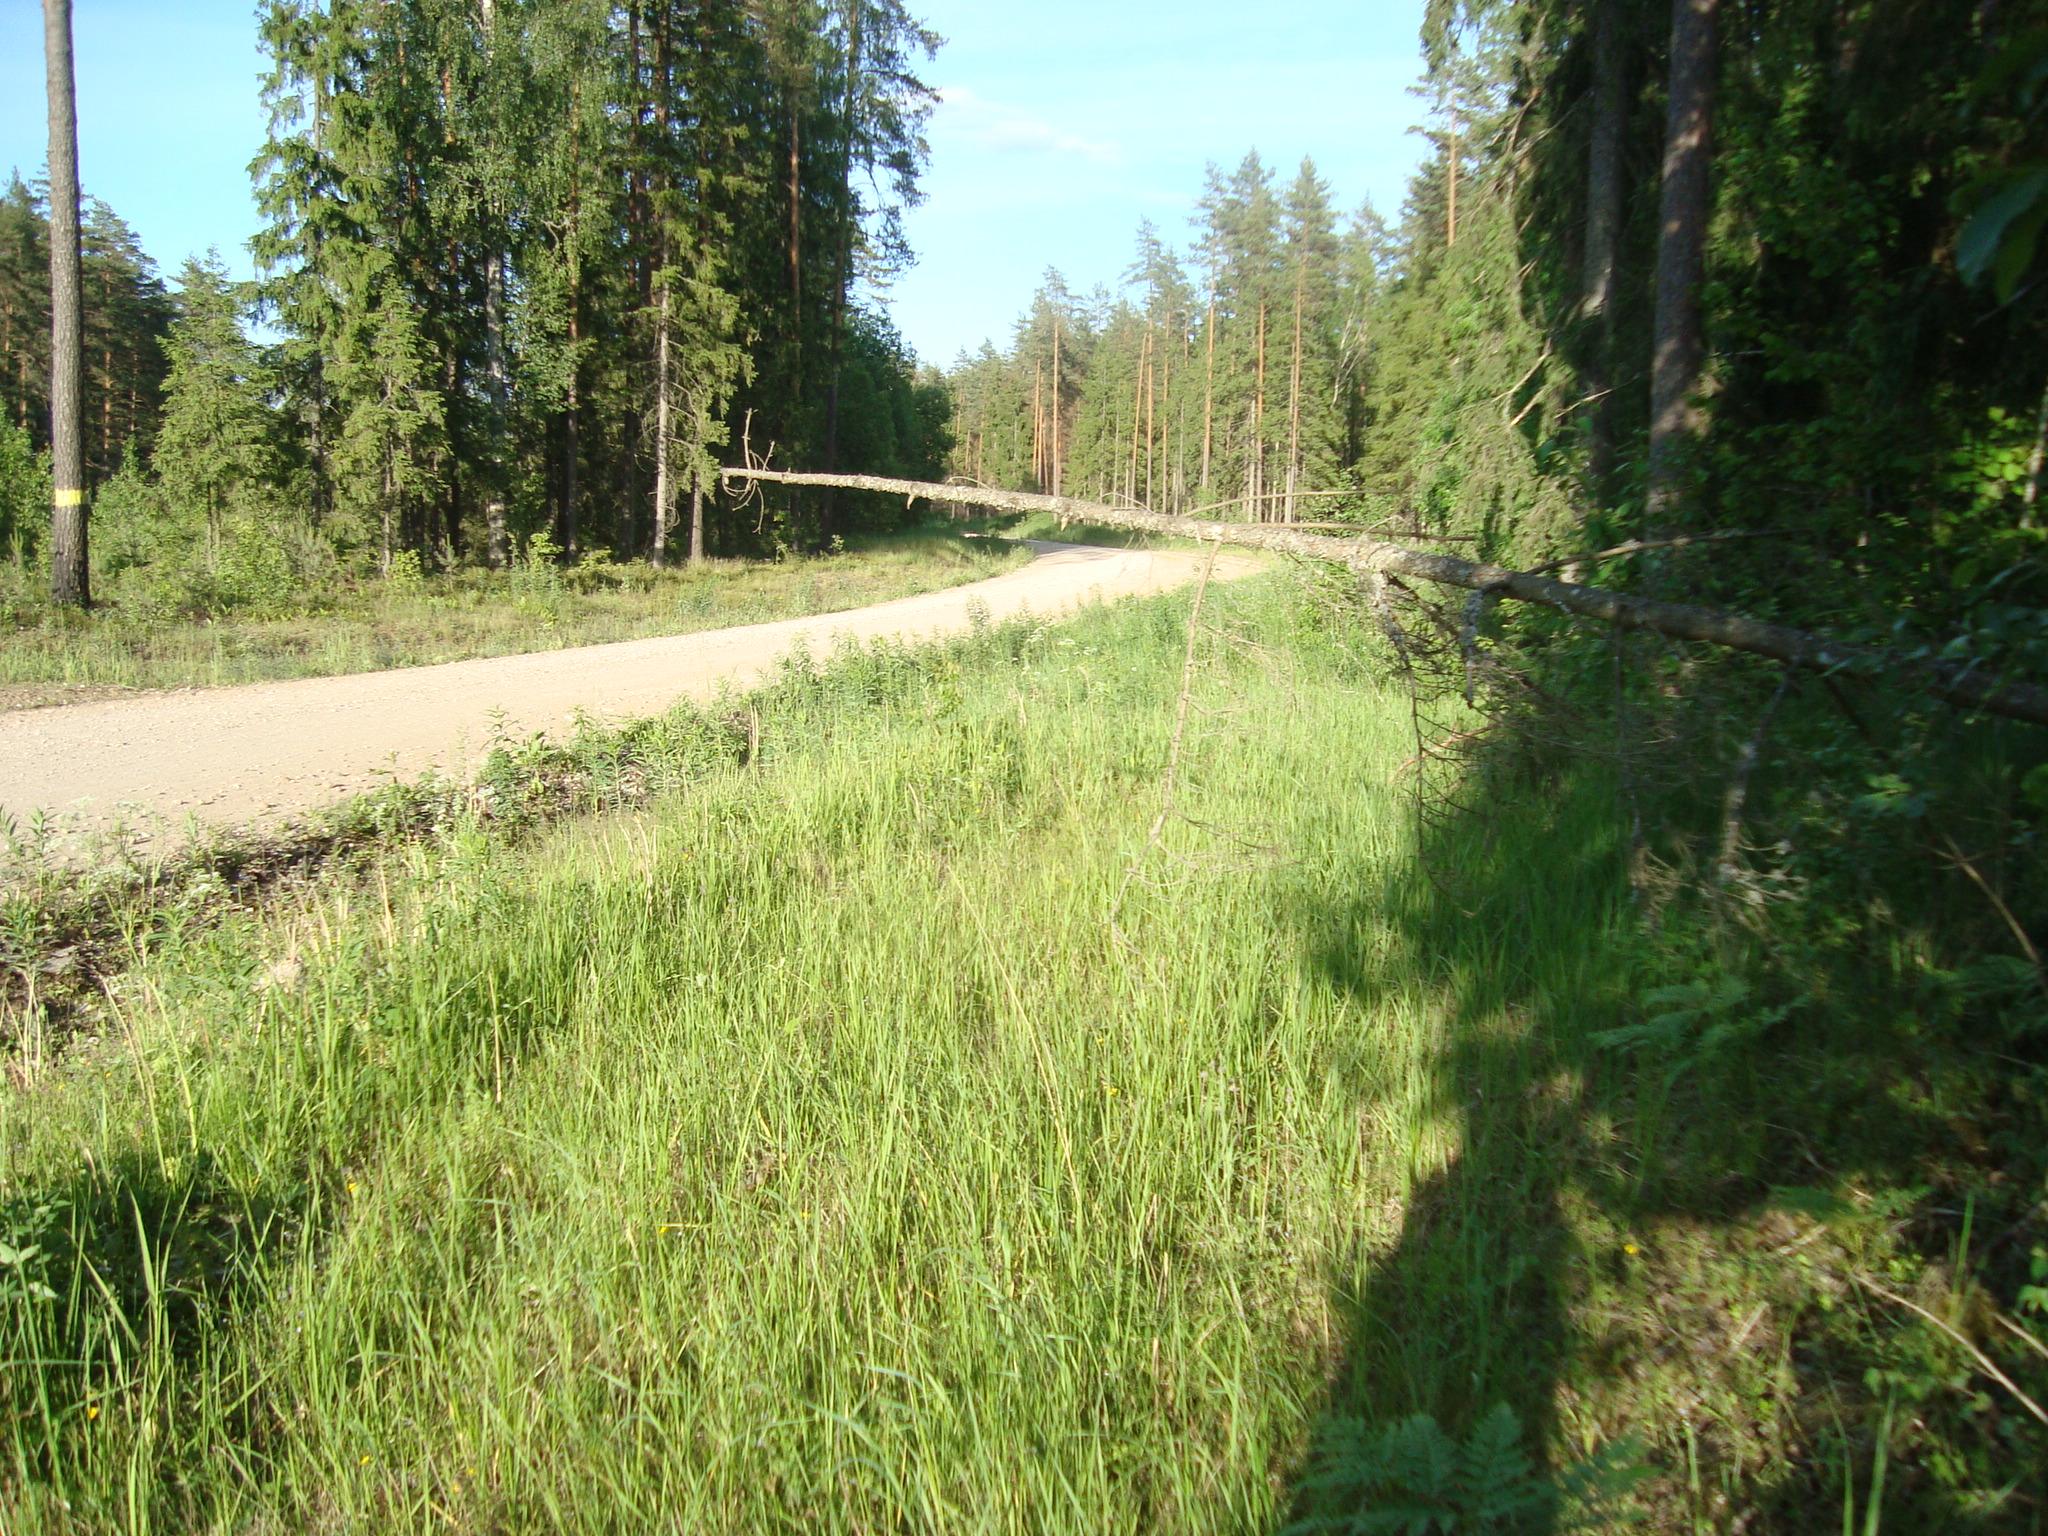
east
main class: Grassland
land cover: Grassland without tree/shrub cover
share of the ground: > 75 %
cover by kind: herbaceous plants 100 %
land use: Road transport
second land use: Forestry
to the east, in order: Grassland without tree/shrub cover; Ditches and canals; Paved roads, cycling and walking lanes; Grass margins; Ditches and canals; Grass margins; Paved roads, cycling and walking lanes
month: June
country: LV
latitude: 56.8243
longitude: 26.1784
